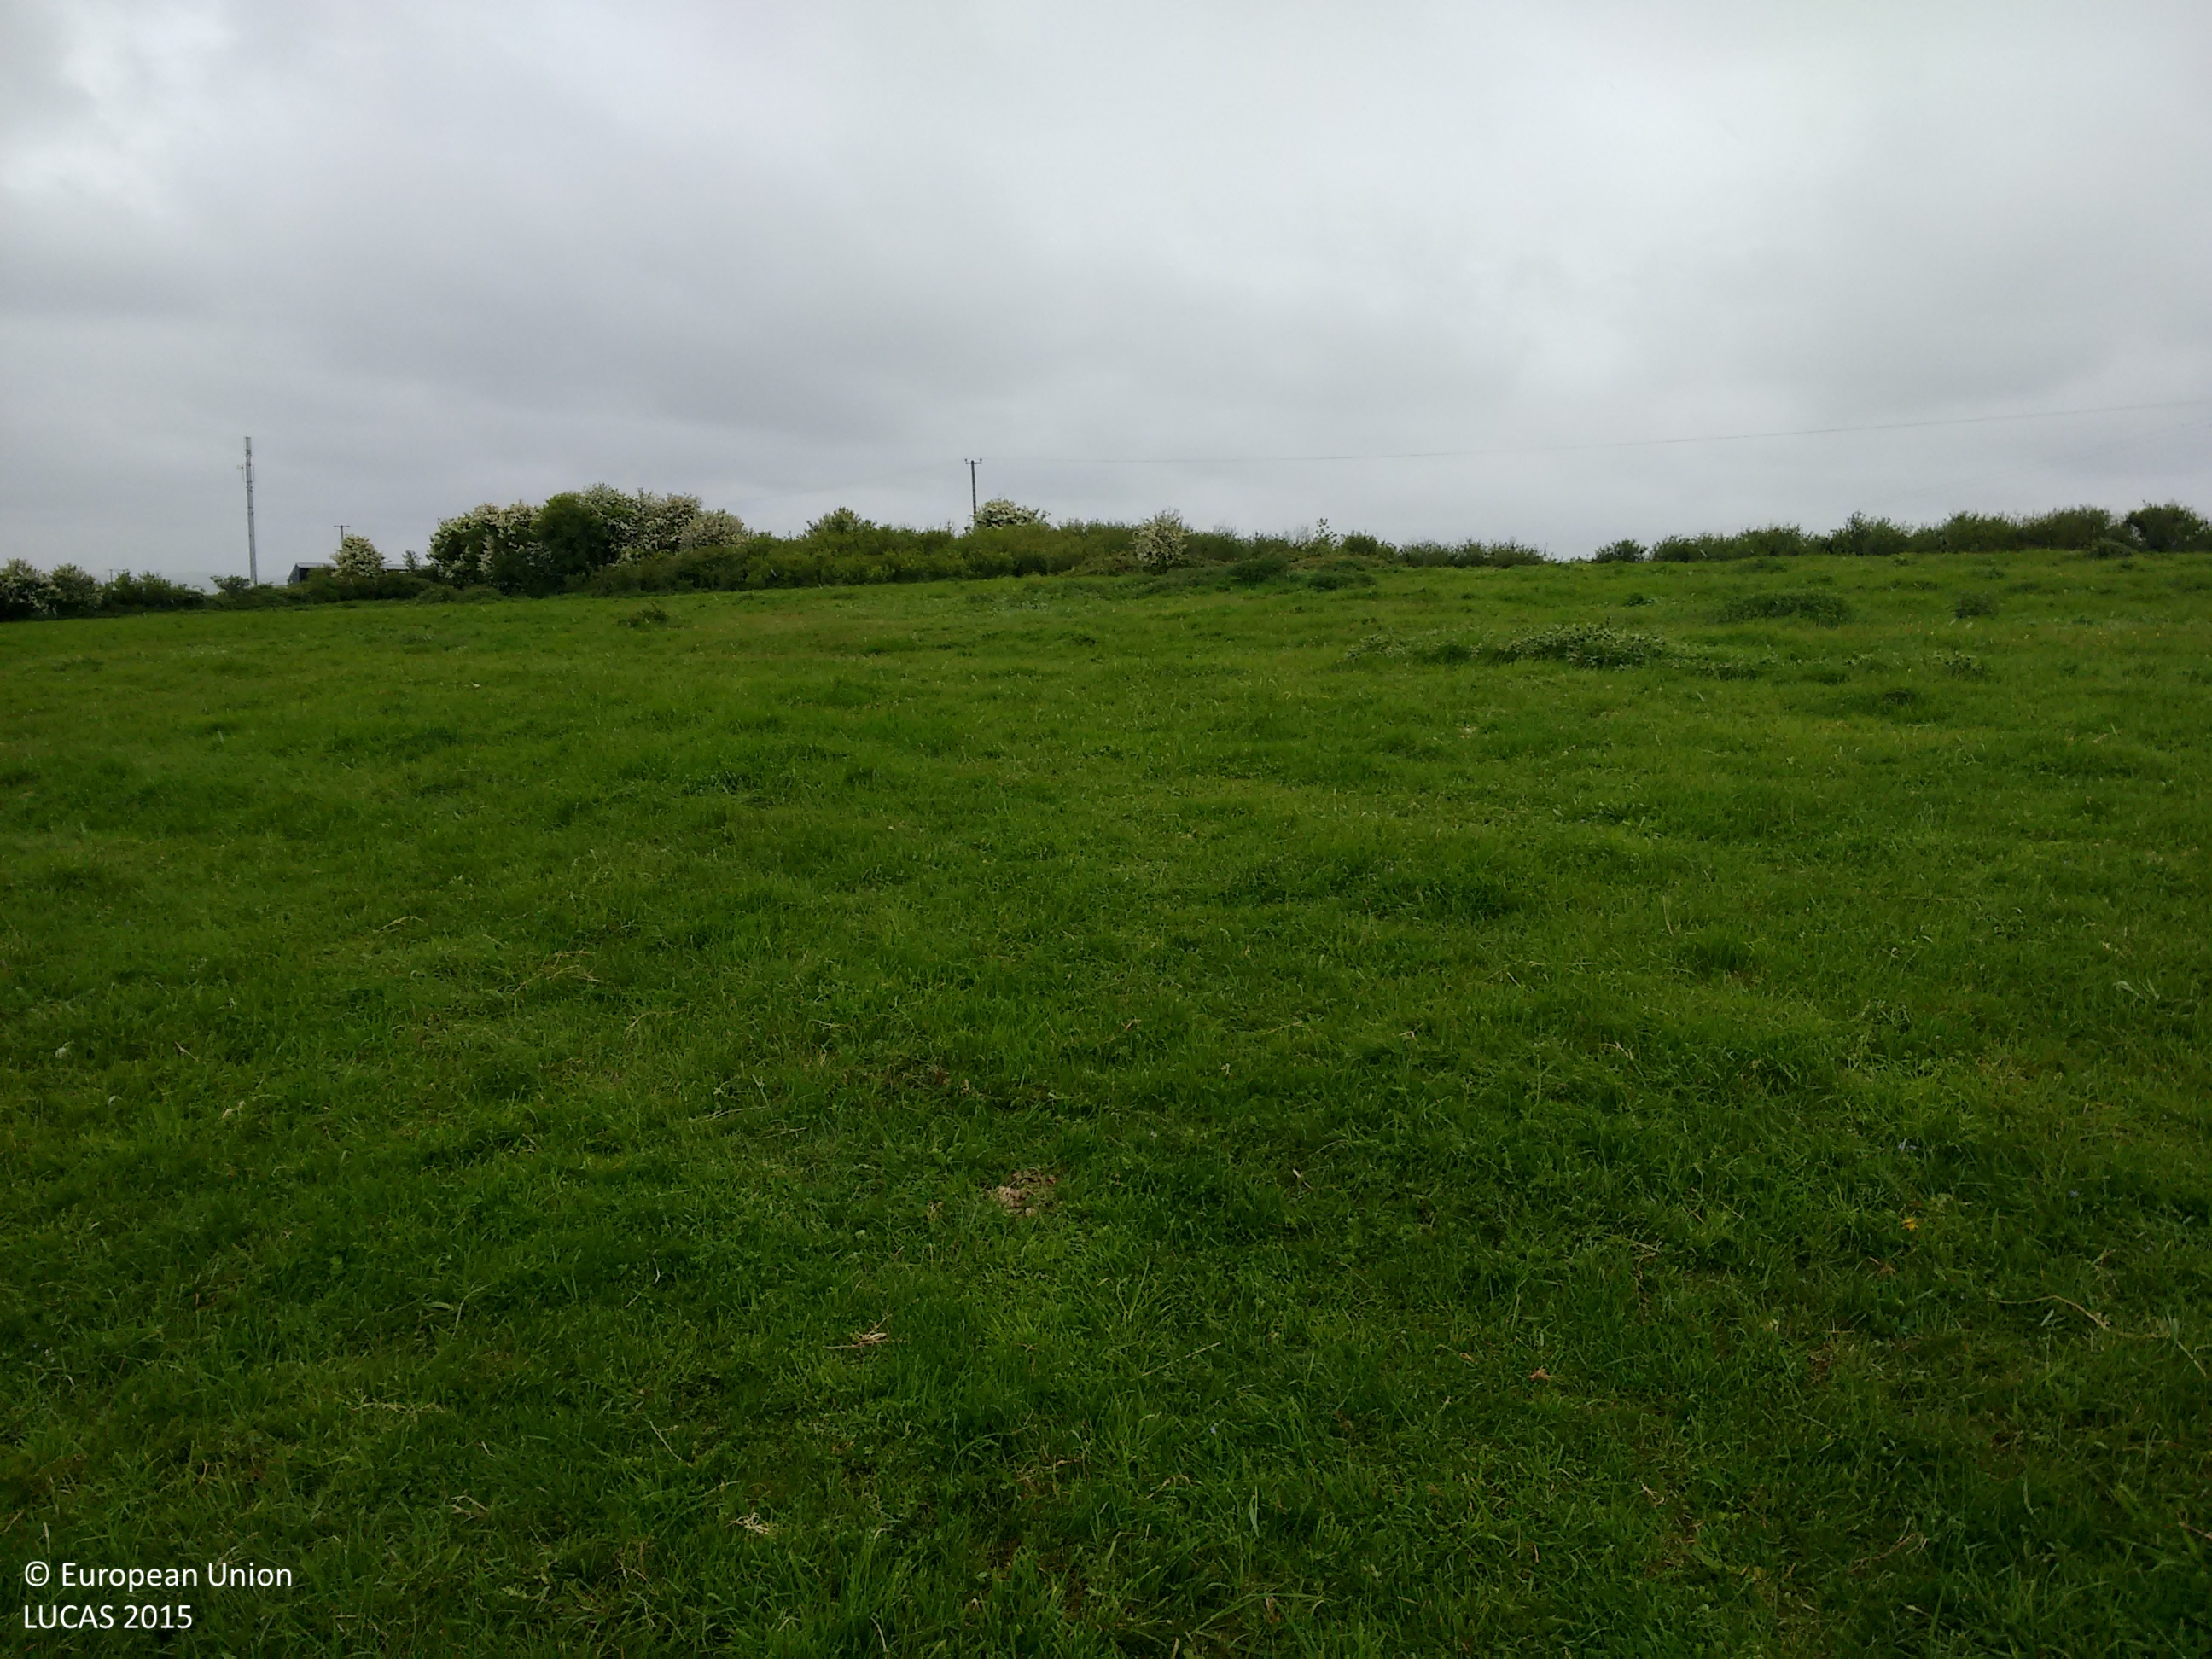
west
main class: Grassland
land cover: Grassland without tree/shrub cover
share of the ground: > 75 %
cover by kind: herbaceous plants 100 %
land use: Agriculture (excluding fallow land and kitchen gardens)
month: May
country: IE
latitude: 53.1407
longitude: -8.8486
